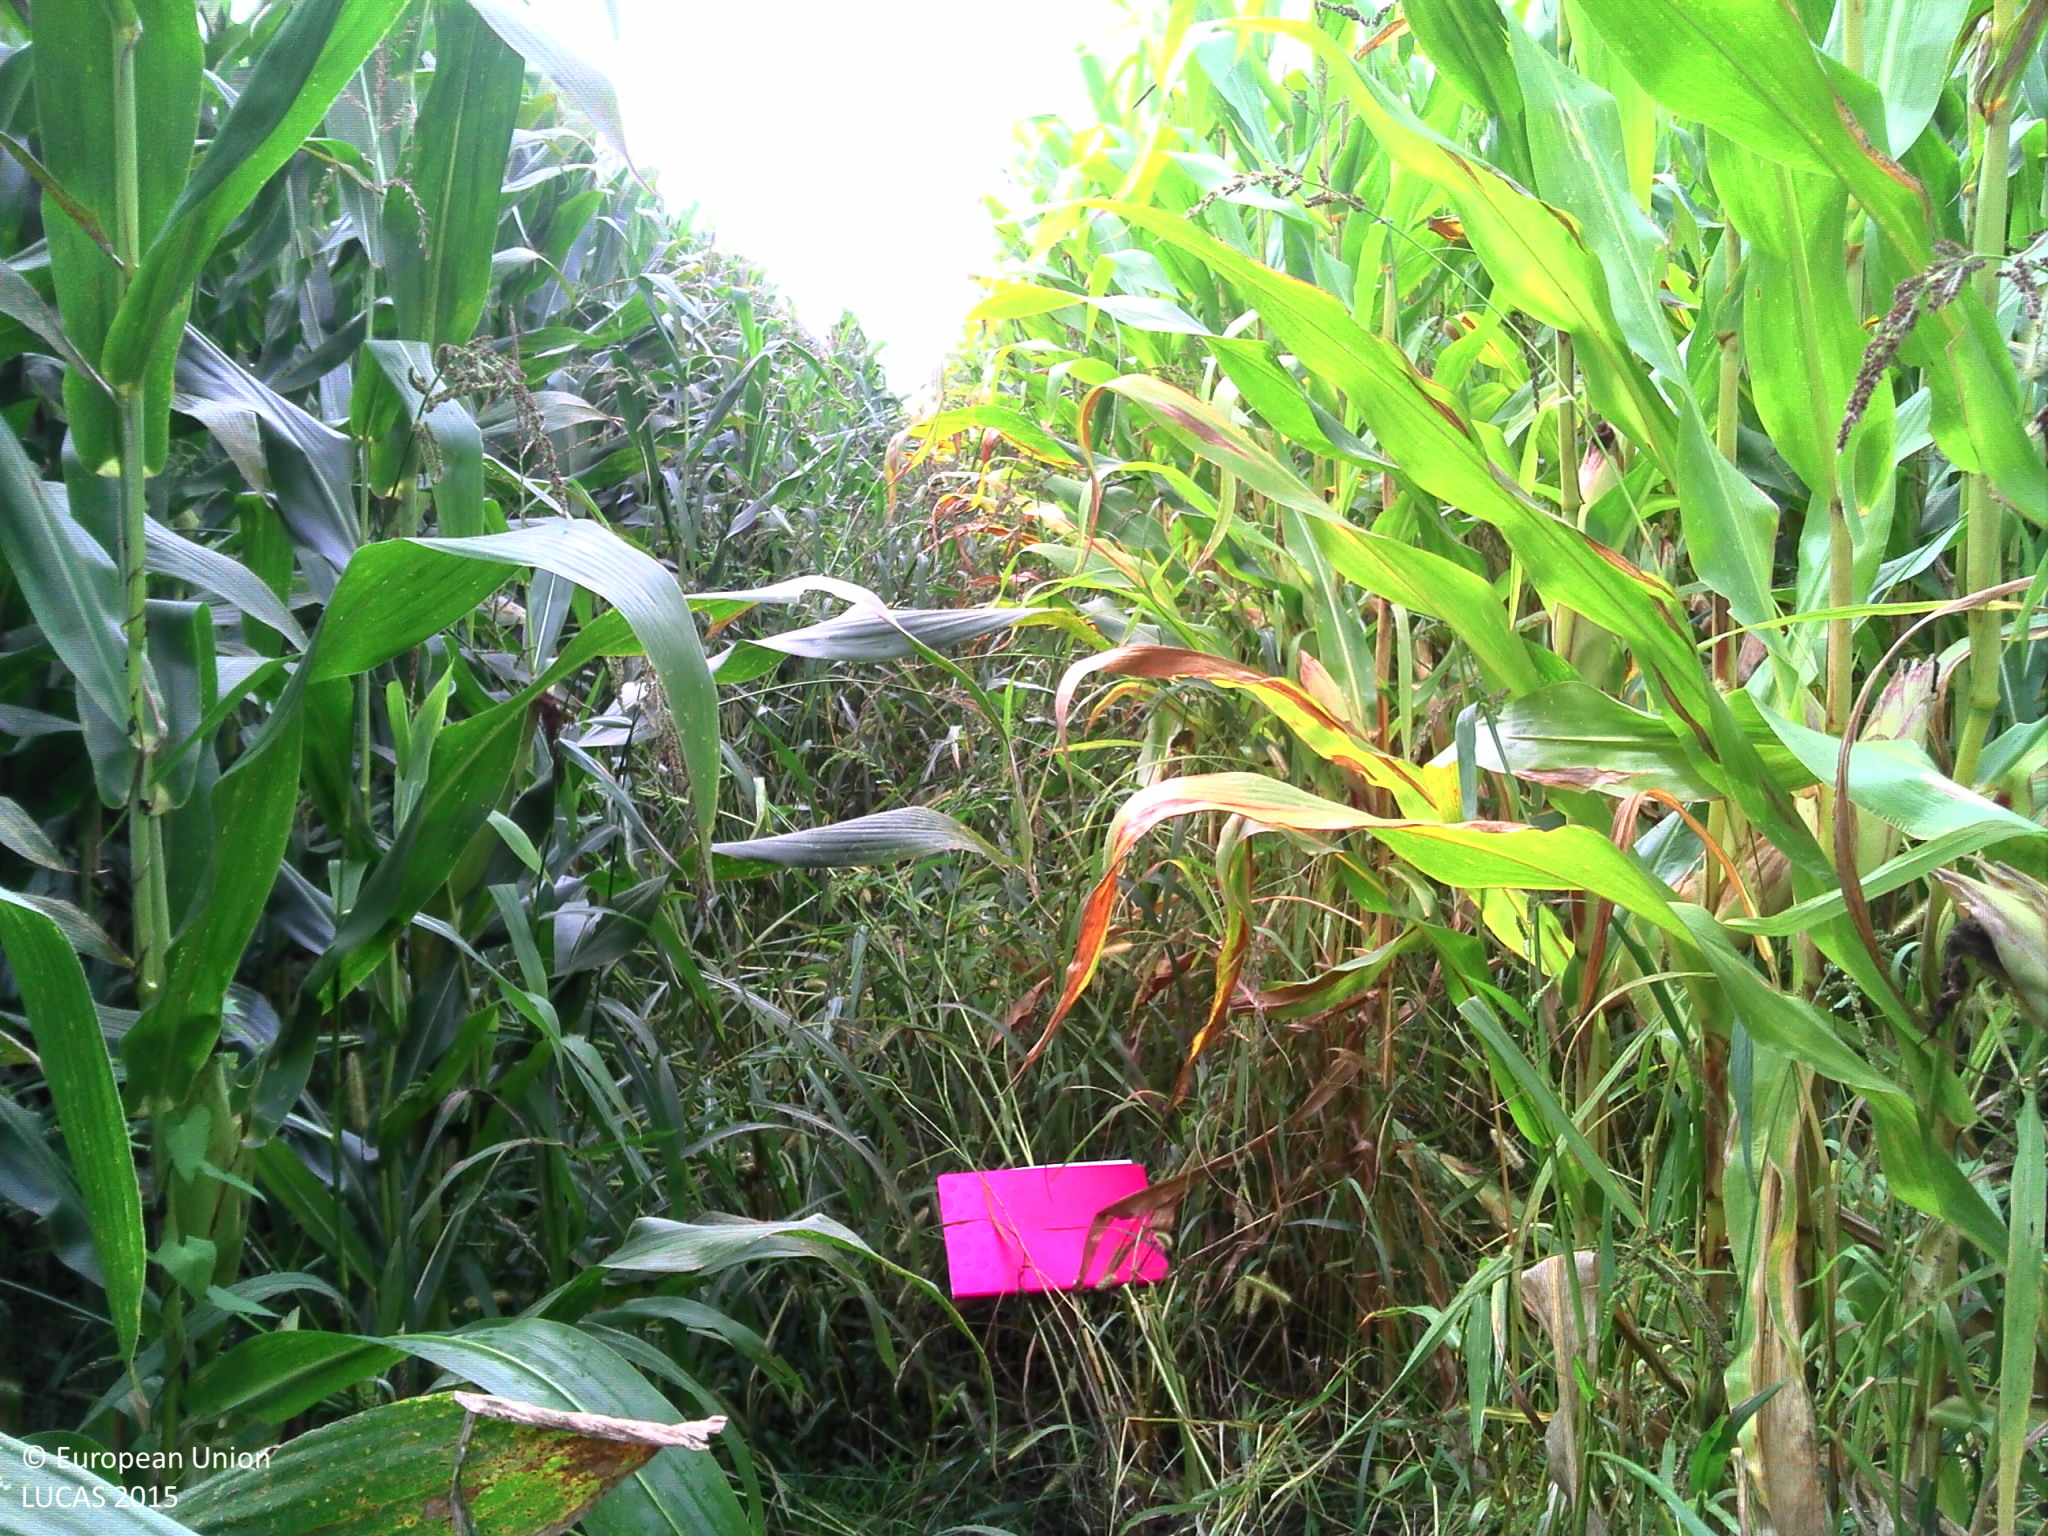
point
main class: Cropland
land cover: Maize
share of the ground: > 75 %
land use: Agriculture (excluding fallow land and kitchen gardens)
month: September
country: FR
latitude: 43.3242
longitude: -0.1543
